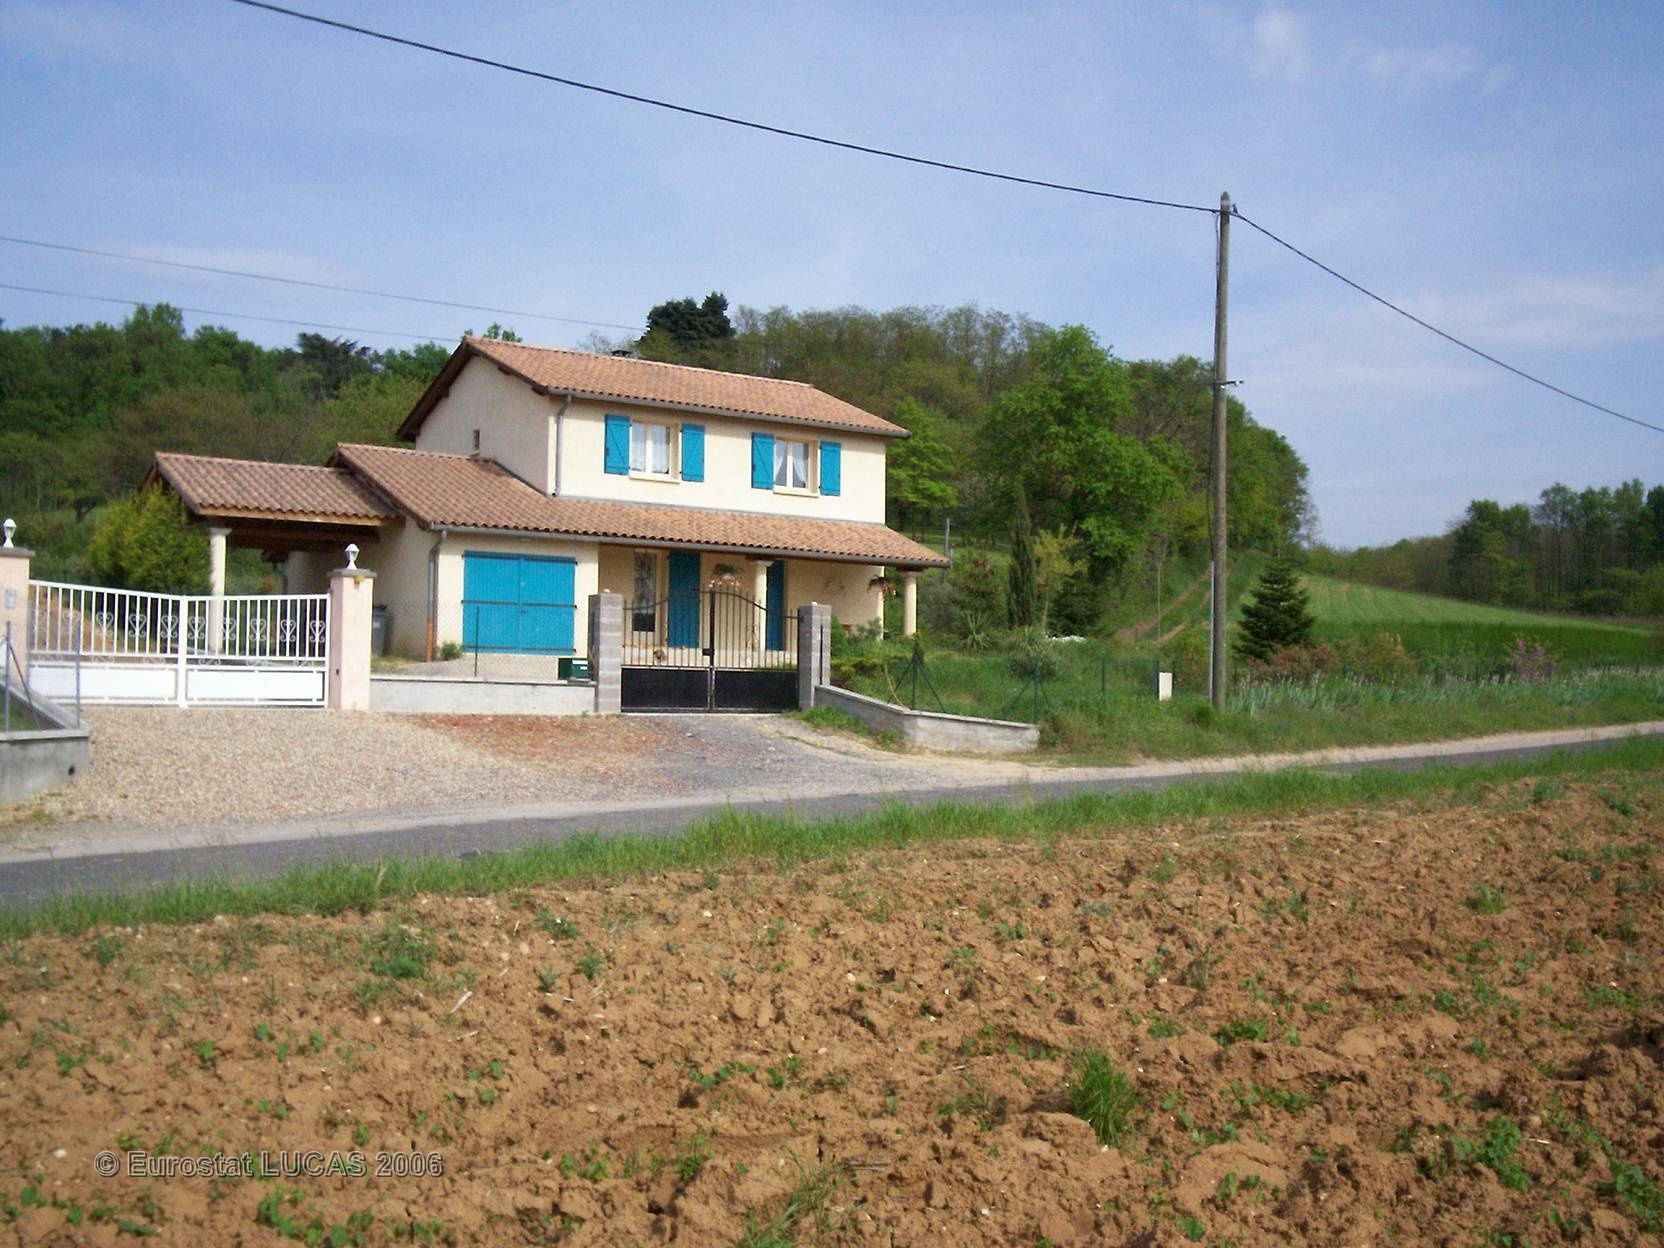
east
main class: Cropland
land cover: Maize
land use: Agriculture (excluding fallow land and kitchen gardens)
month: June
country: FR
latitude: 45.9529
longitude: 4.7779
